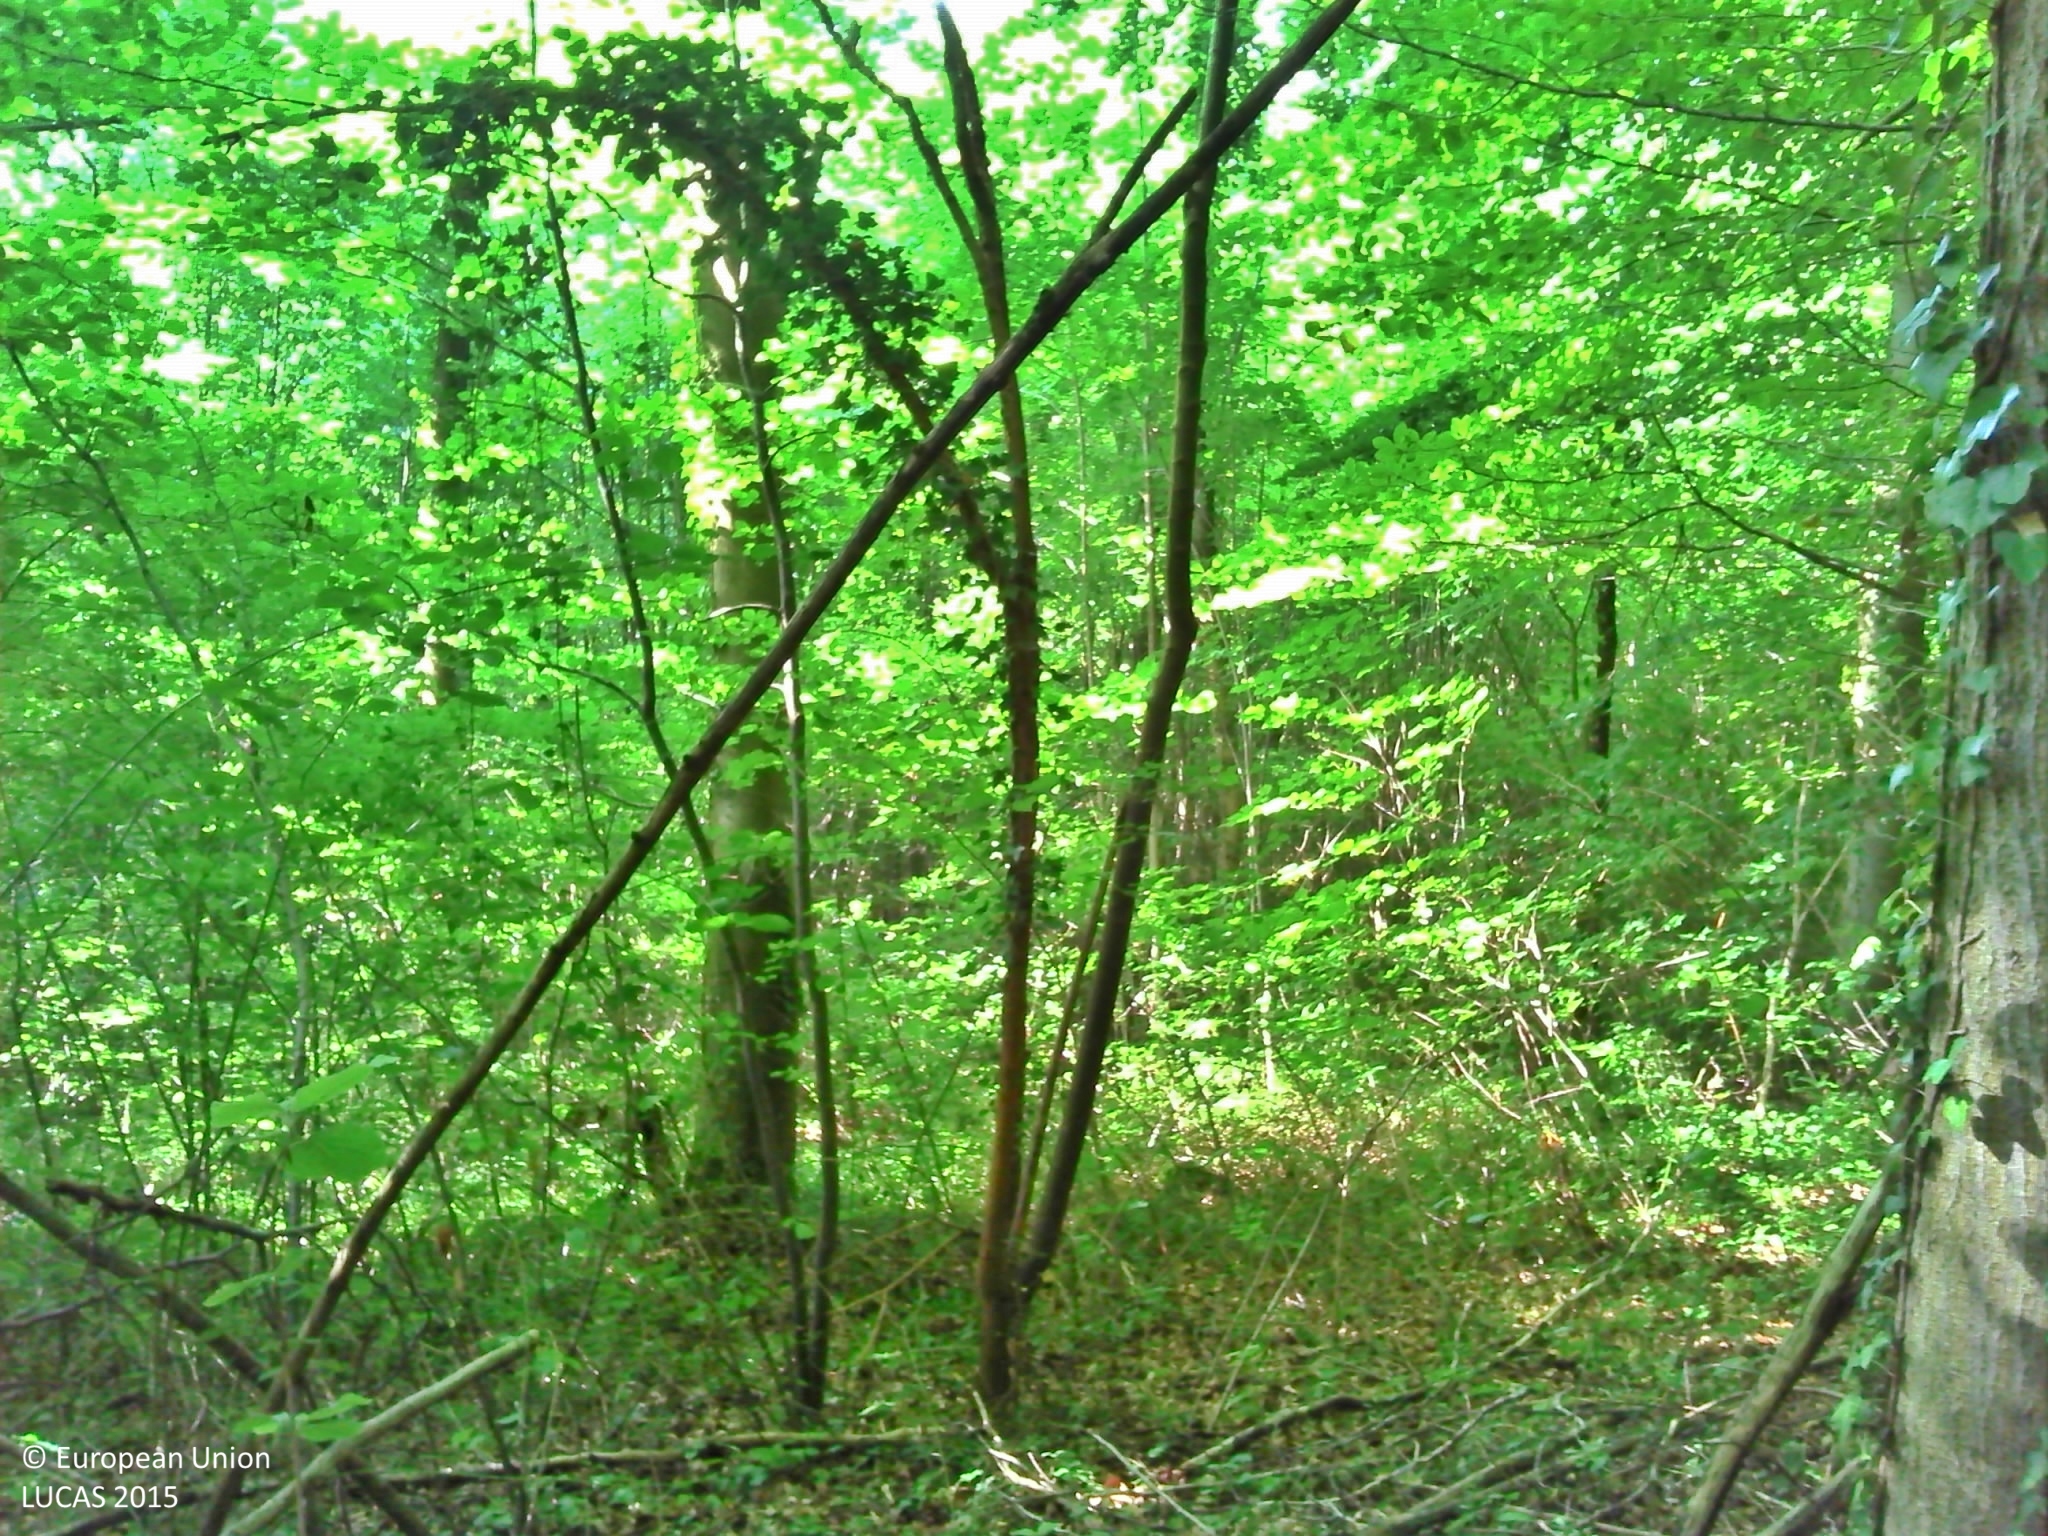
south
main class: Woodland
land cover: Broadleaved woodland
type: beech forest
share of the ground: > 75 %
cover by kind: broadleaved forest trees 70 %, shrubs 15 %, herbaceous plants 15 %
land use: Forestry
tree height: > 5 m
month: July
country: FR
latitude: 49.2951
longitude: 2.3559
